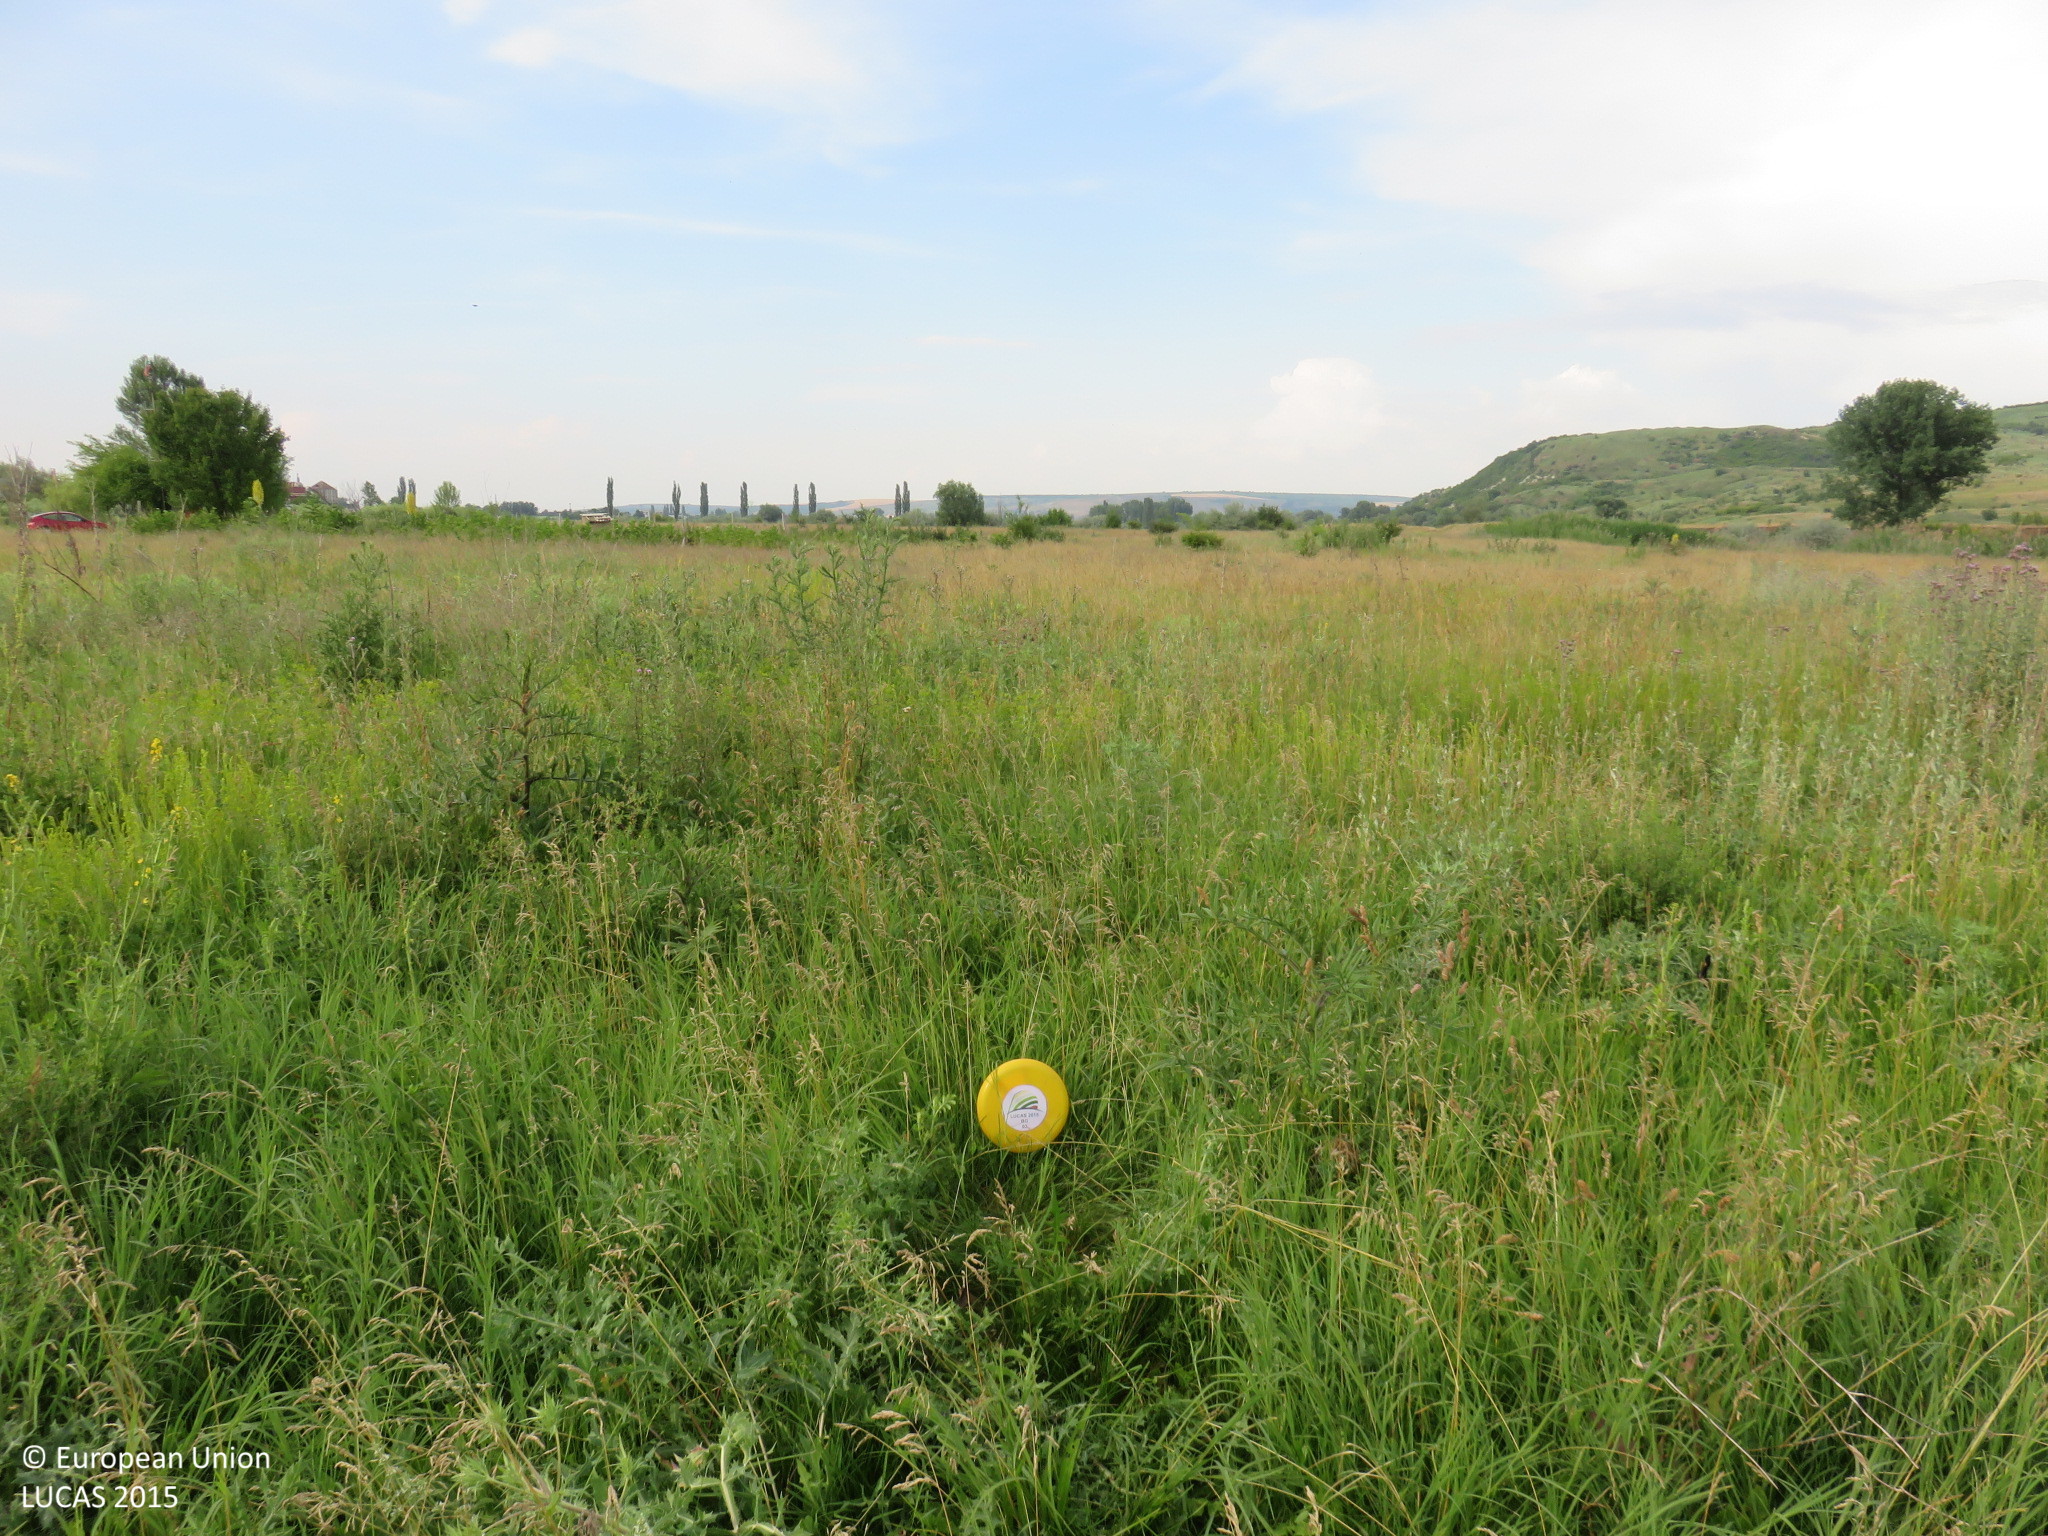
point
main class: Grassland
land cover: Grassland without tree/shrub cover
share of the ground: > 75 %
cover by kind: herbaceous plants 100 %
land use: Semi-natural and natural areas not in use
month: June
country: BG
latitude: 43.4140
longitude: 24.5230
